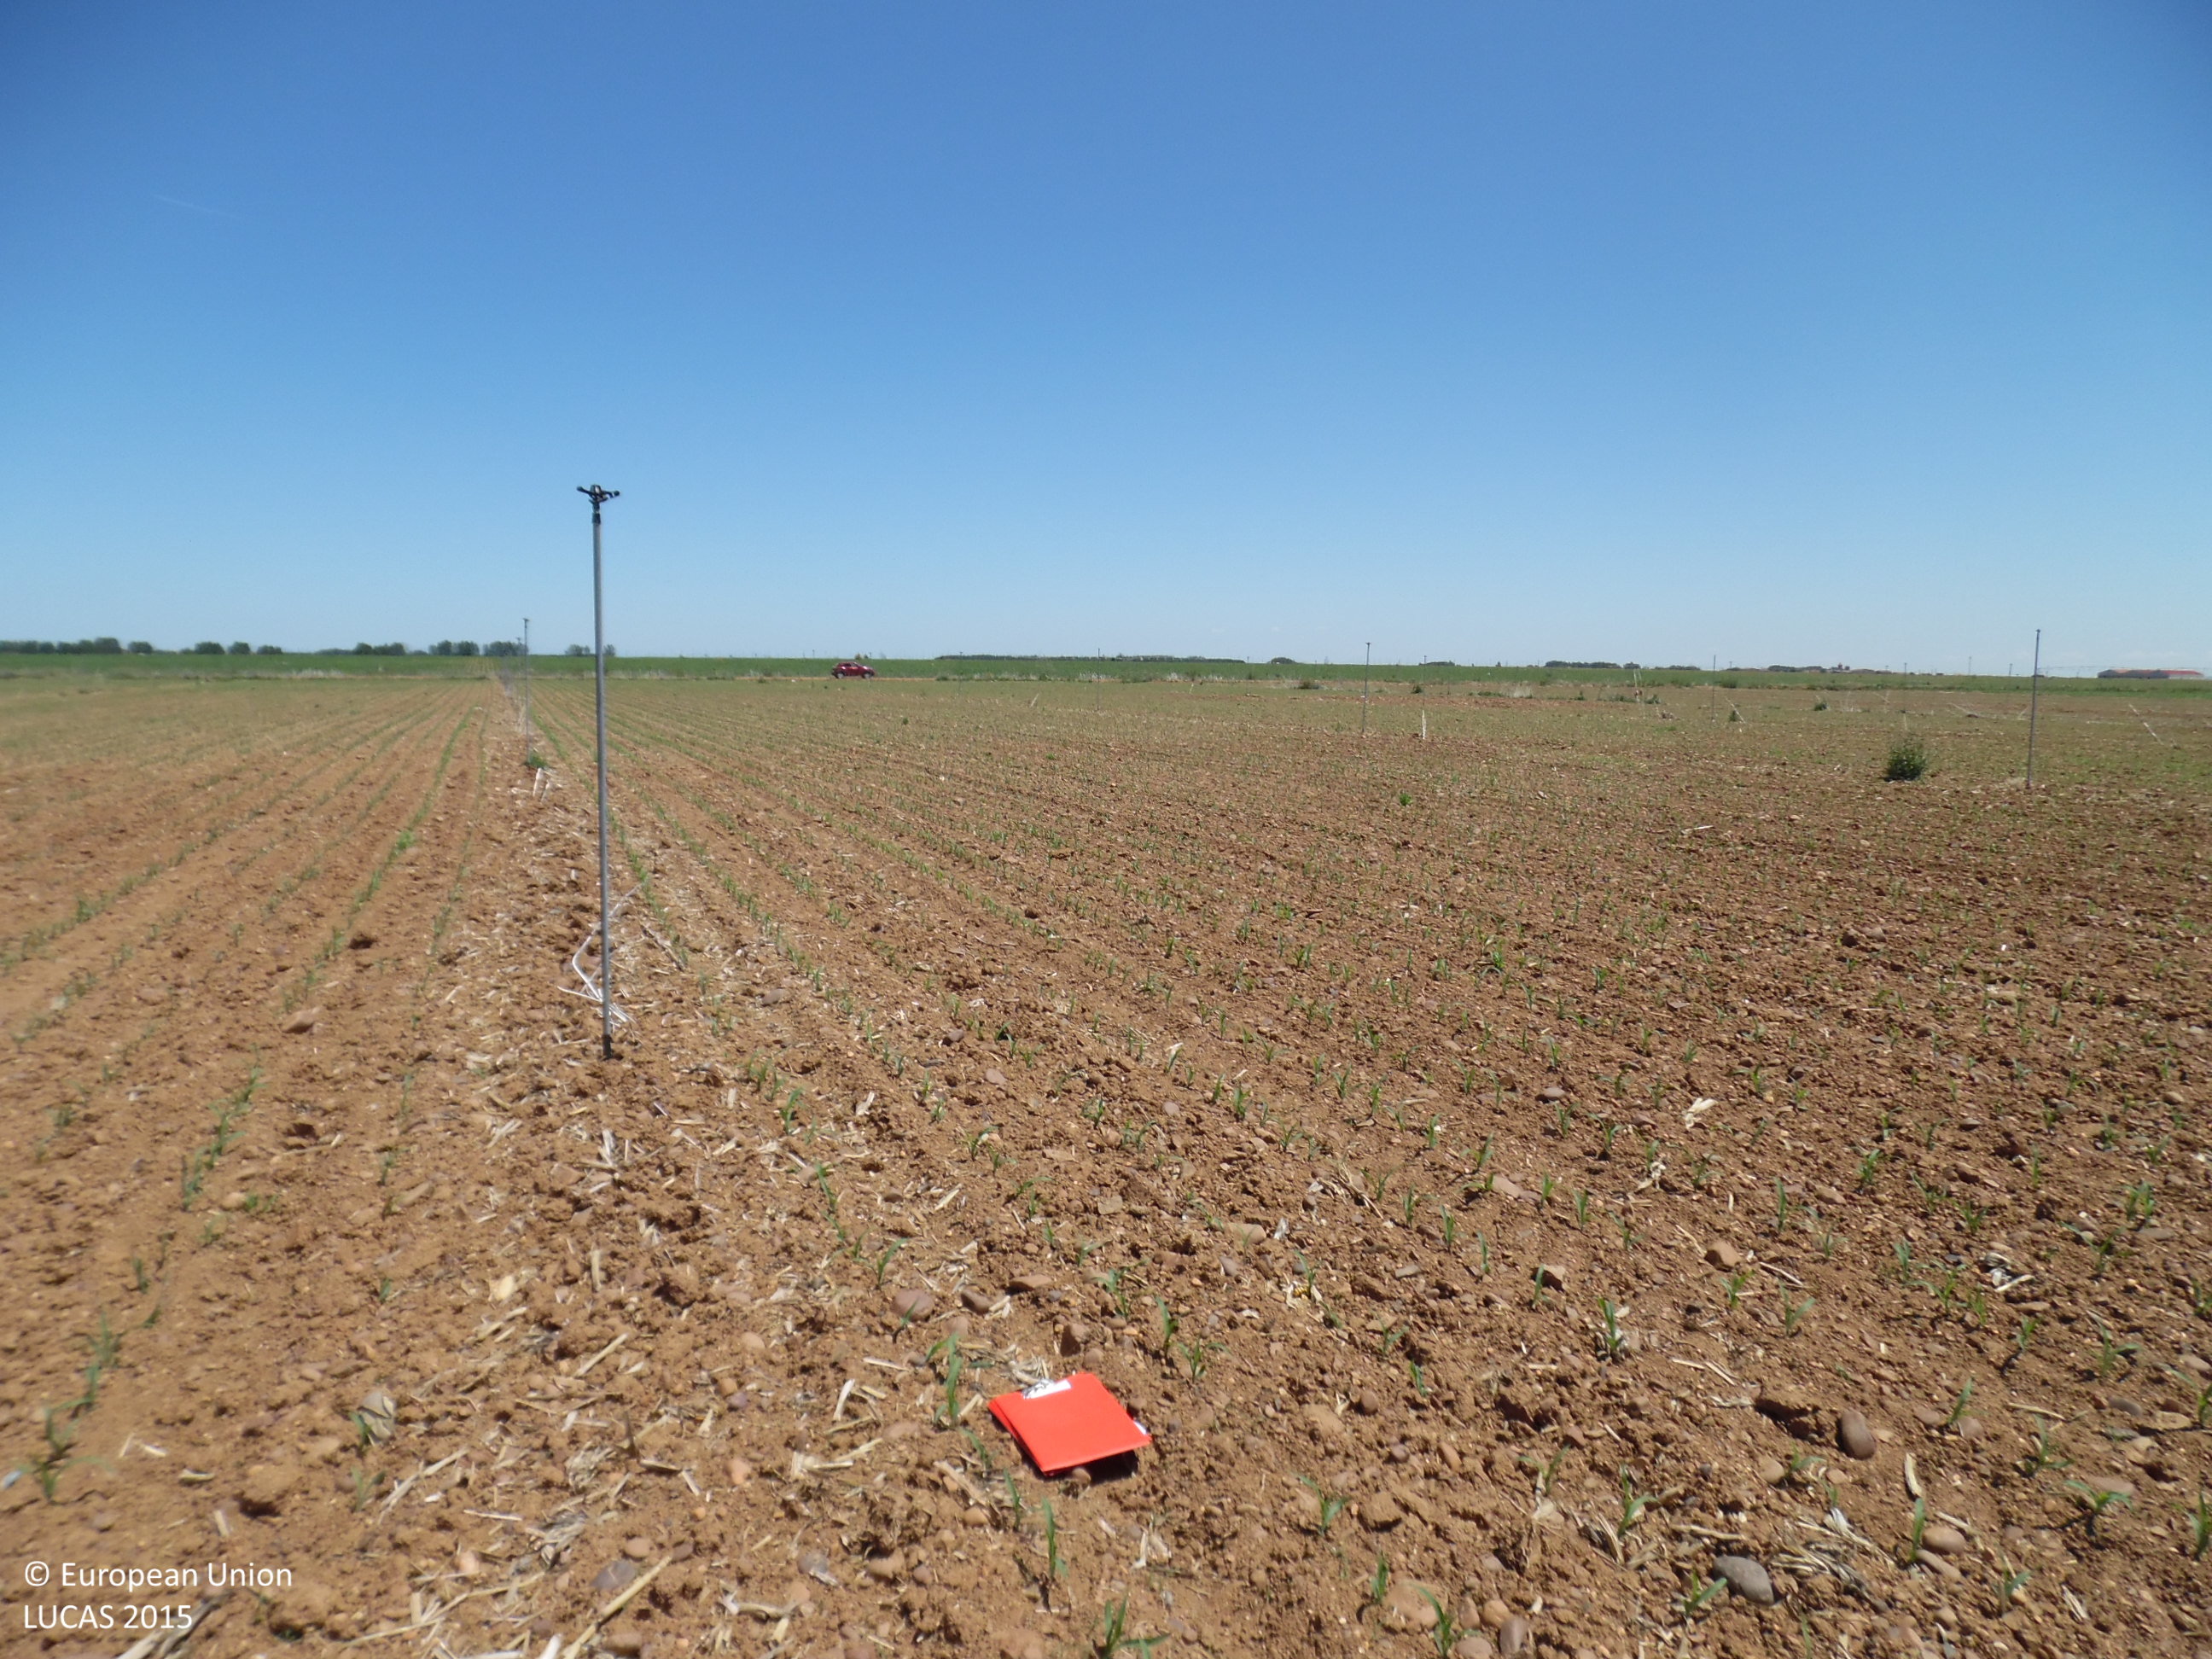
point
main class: Cropland
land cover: Maize
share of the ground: < 10 %
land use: Agriculture (excluding fallow land and kitchen gardens)
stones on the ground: 10 - 25 %
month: June
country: ES
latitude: 42.3965
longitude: -5.6835
